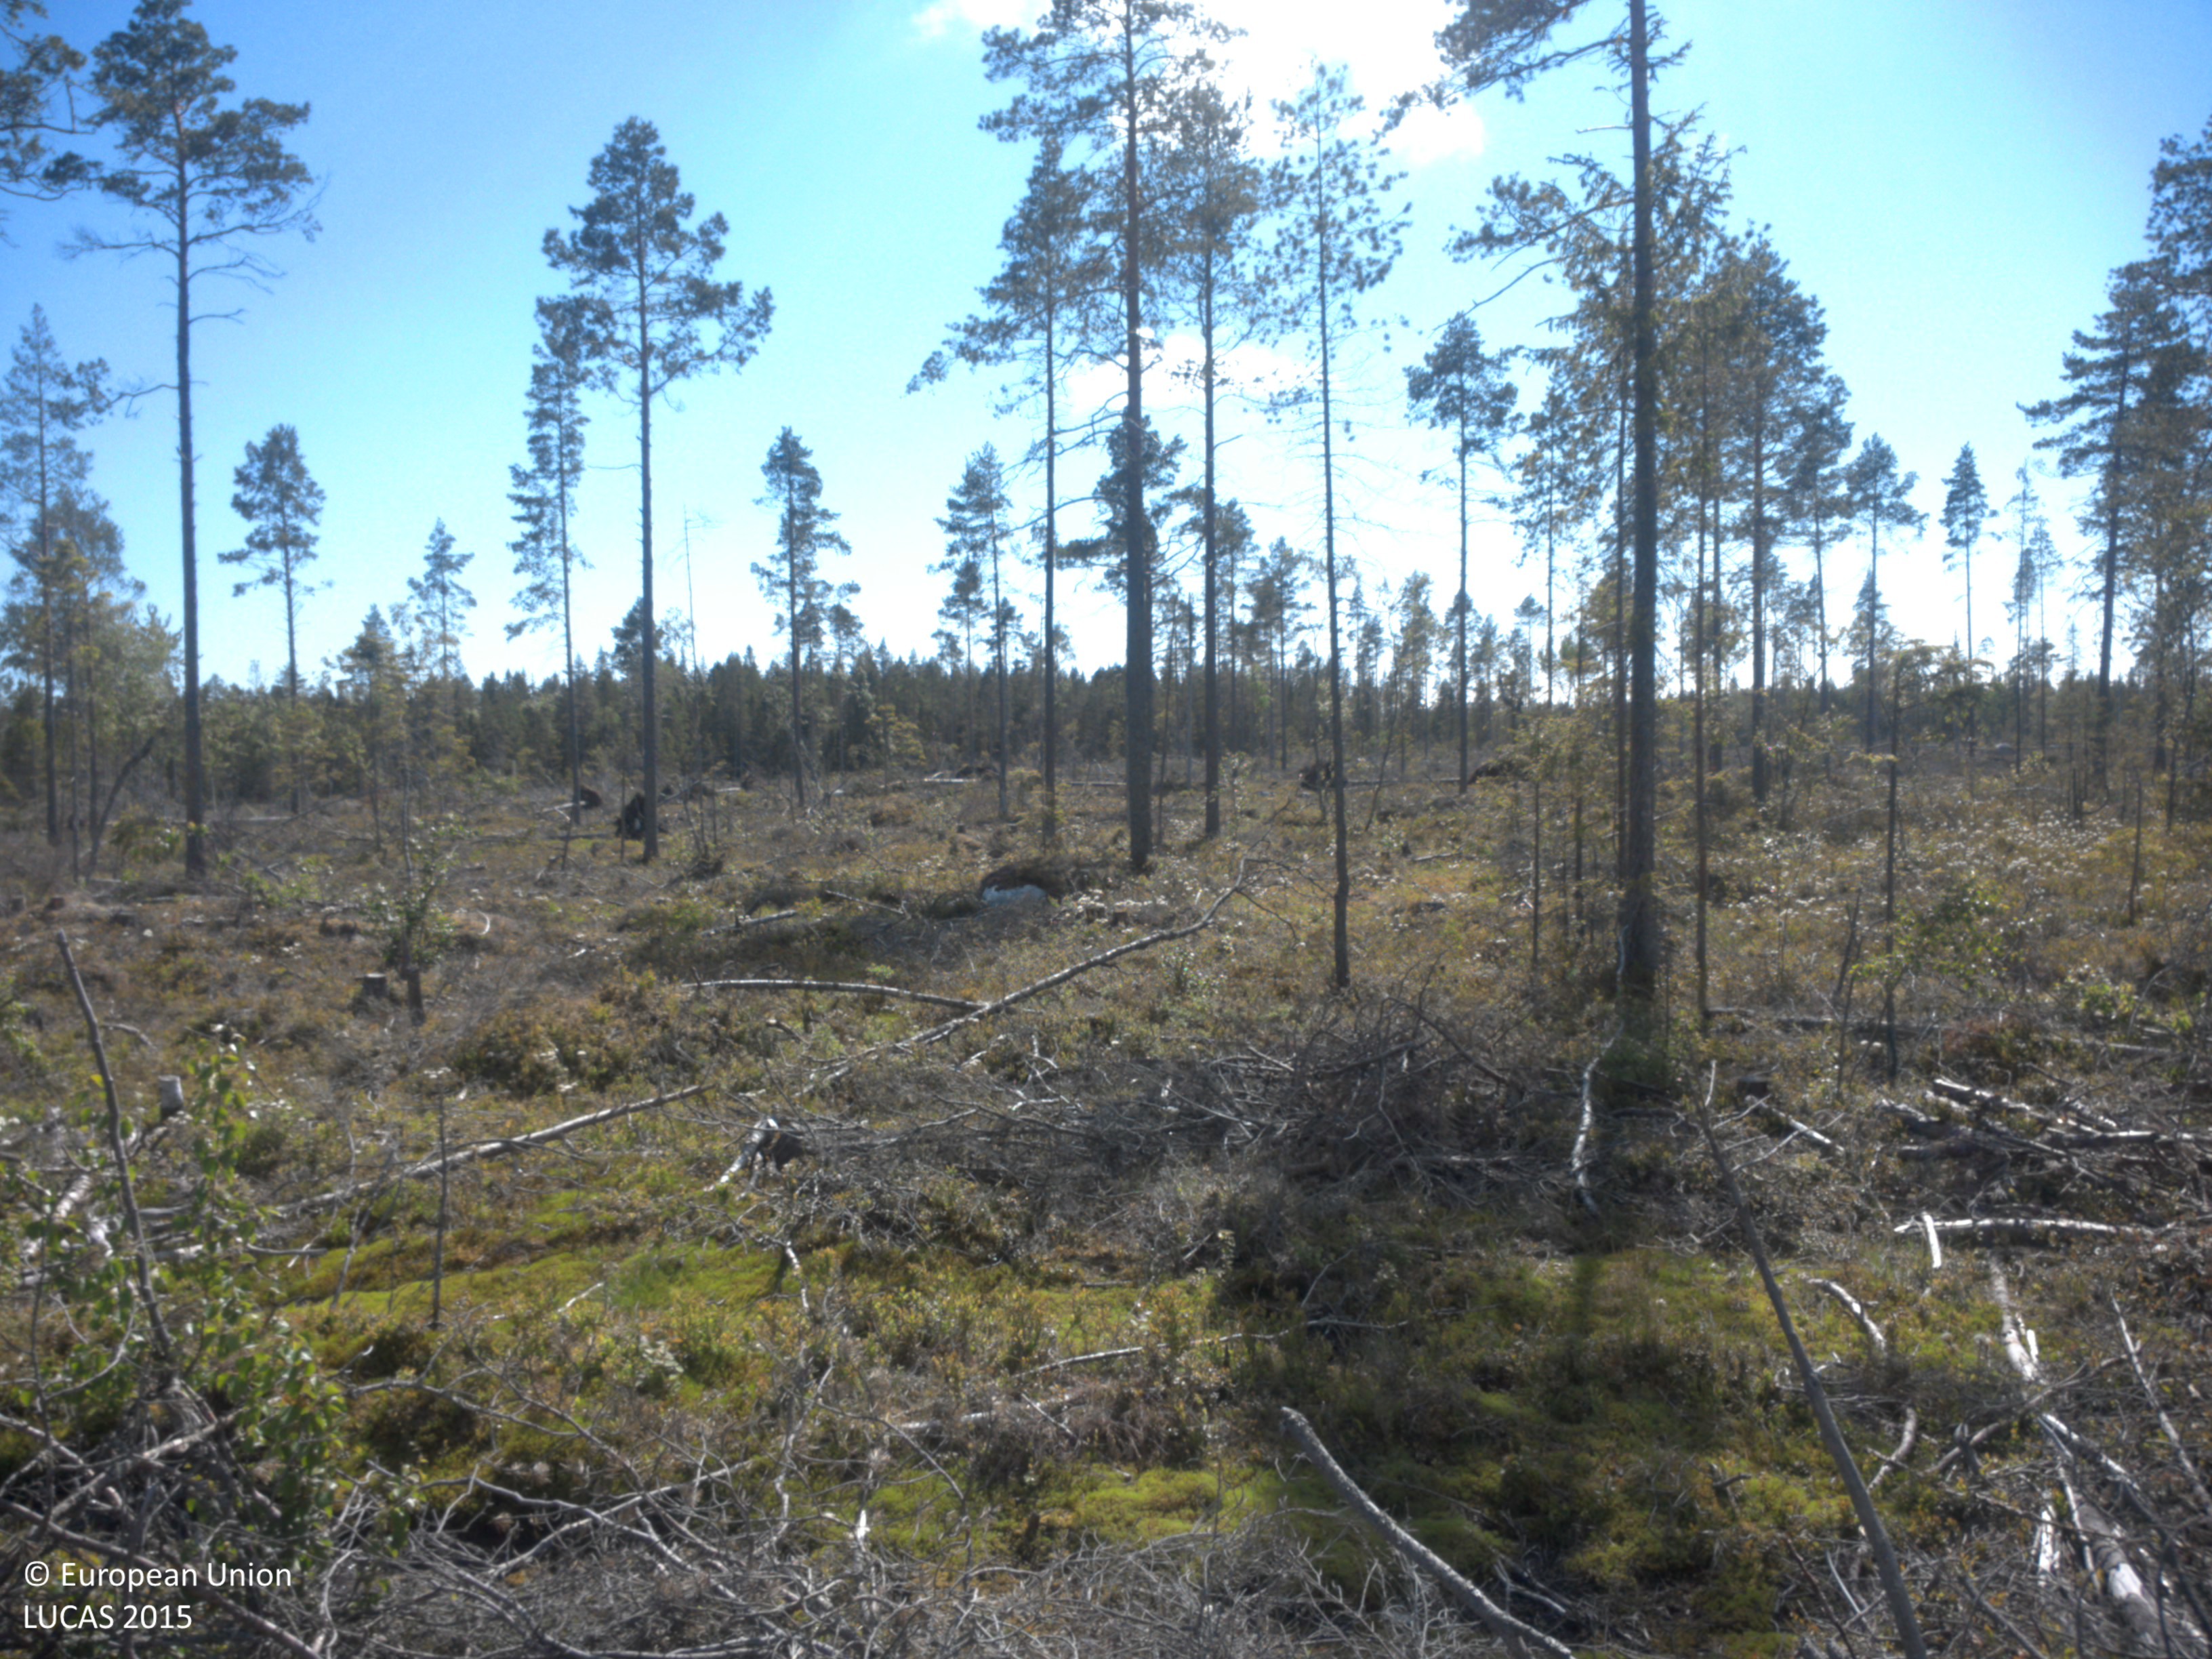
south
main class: Shrubland
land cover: Shrubland with sparse tree cover
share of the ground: > 75 %
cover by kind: shrubs 85 %, unconsolidated bare surface 10 %, coniferous forest trees 5 %
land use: Forestry
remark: Clear cut
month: June
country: SE
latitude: 63.4983
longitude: 19.7233
